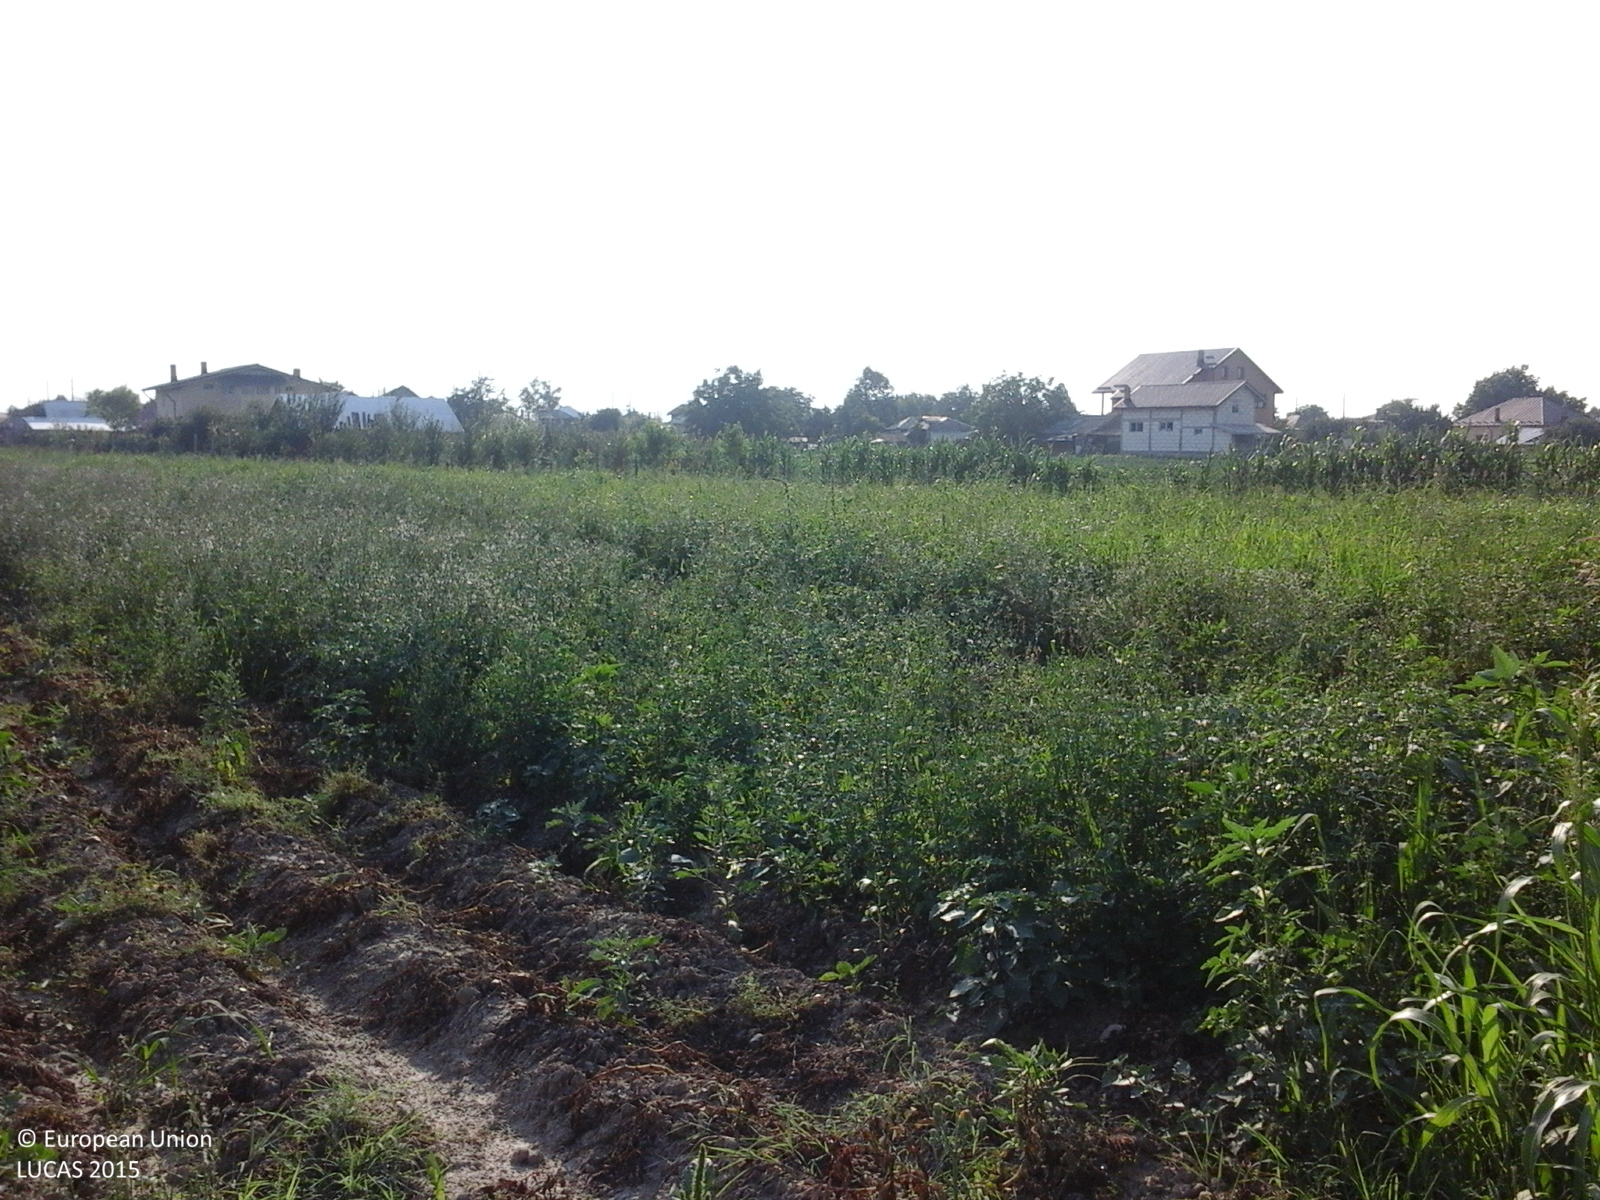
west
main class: Cropland
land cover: Potatoes
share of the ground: 50 - 75 %
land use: Agriculture (excluding fallow land and kitchen gardens)
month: July
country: RO
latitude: 44.6201
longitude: 25.6611
